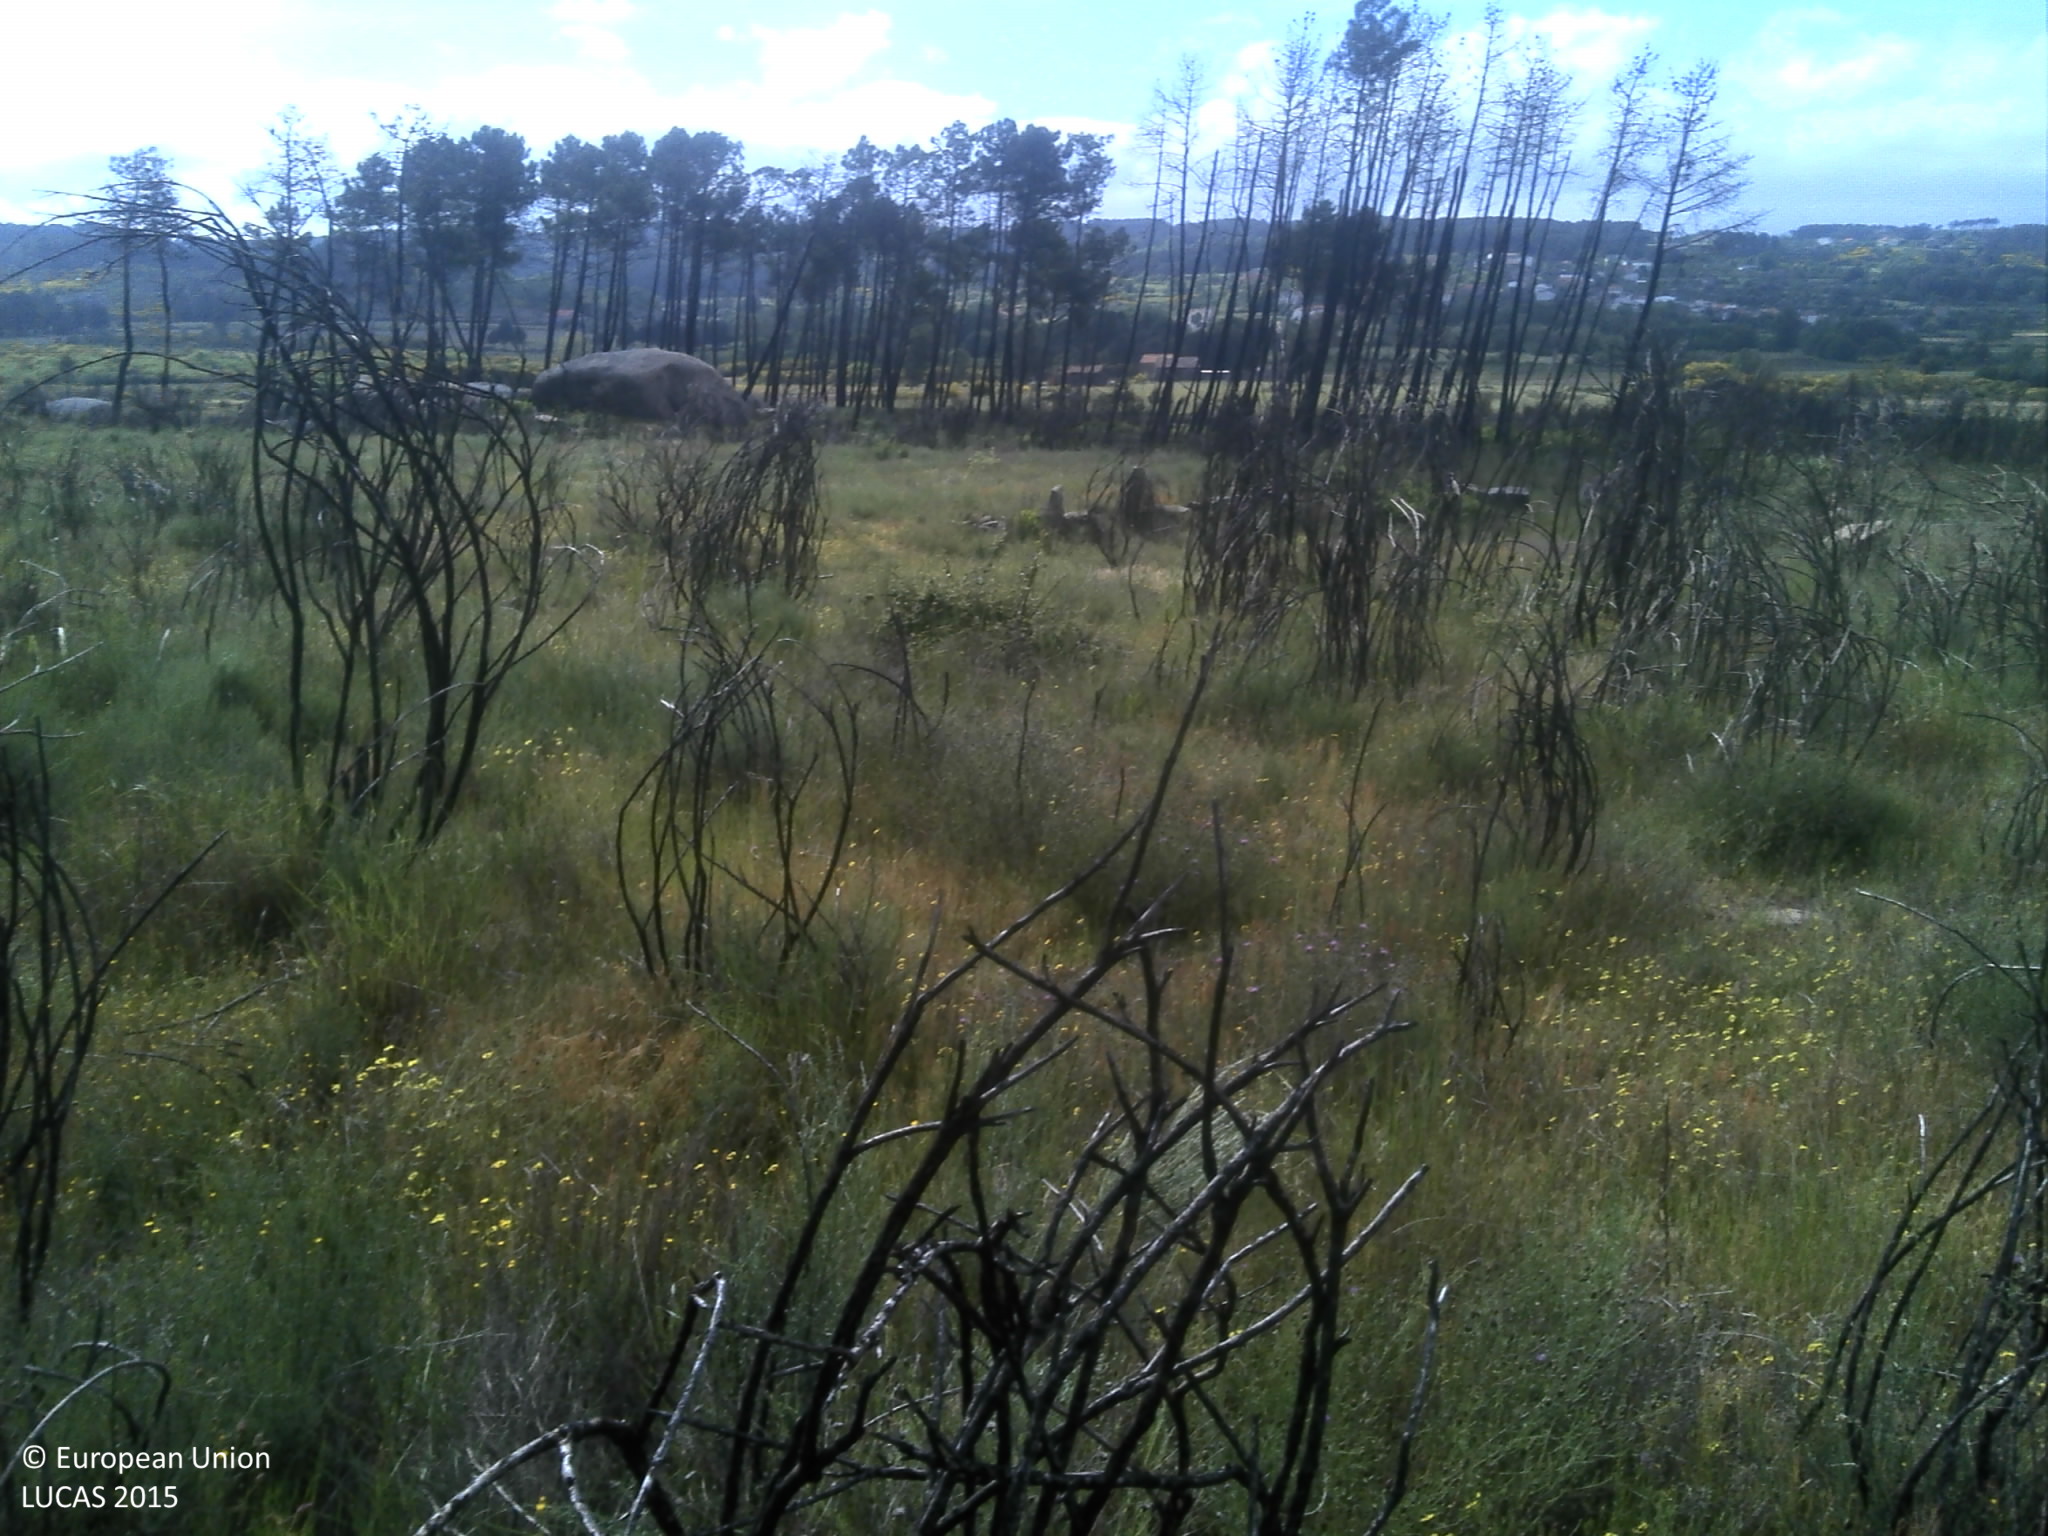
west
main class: Shrubland
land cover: Shrubland without tree cover
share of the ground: 25 - 50 %
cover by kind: shrubs 45 %, herbaceous plants 30 %, unconsolidated bare surface 20 %
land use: Abandoned areas
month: May
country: PT
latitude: 40.6668
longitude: -7.5391
